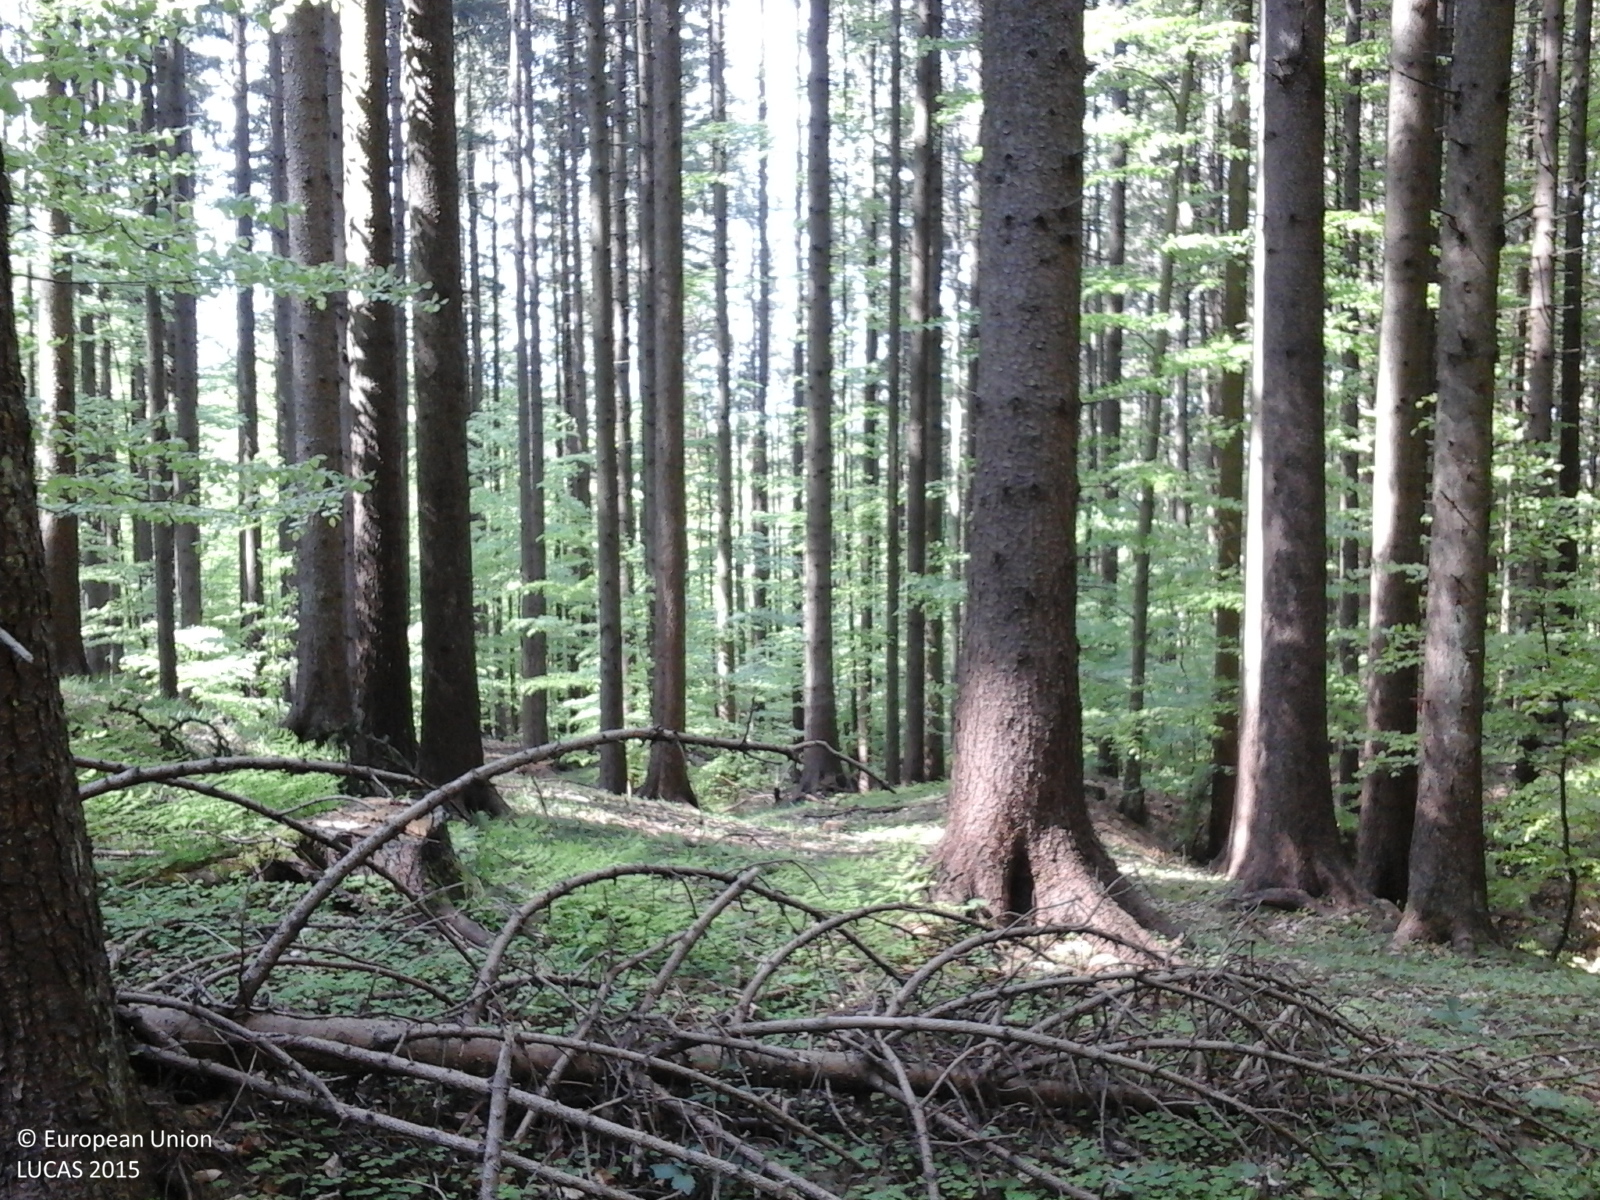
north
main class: Woodland
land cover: Spruce dominated coniferous woodland
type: hemiboreal forest and nemoral coniferous forest and mixed broadleaved-coniferous forest
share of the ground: > 75 %
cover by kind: coniferous forest trees 90 %, broadleaved forest trees 10 %
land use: Forestry
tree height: > 5 m
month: May
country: RO
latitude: 45.6564
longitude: 25.9623
